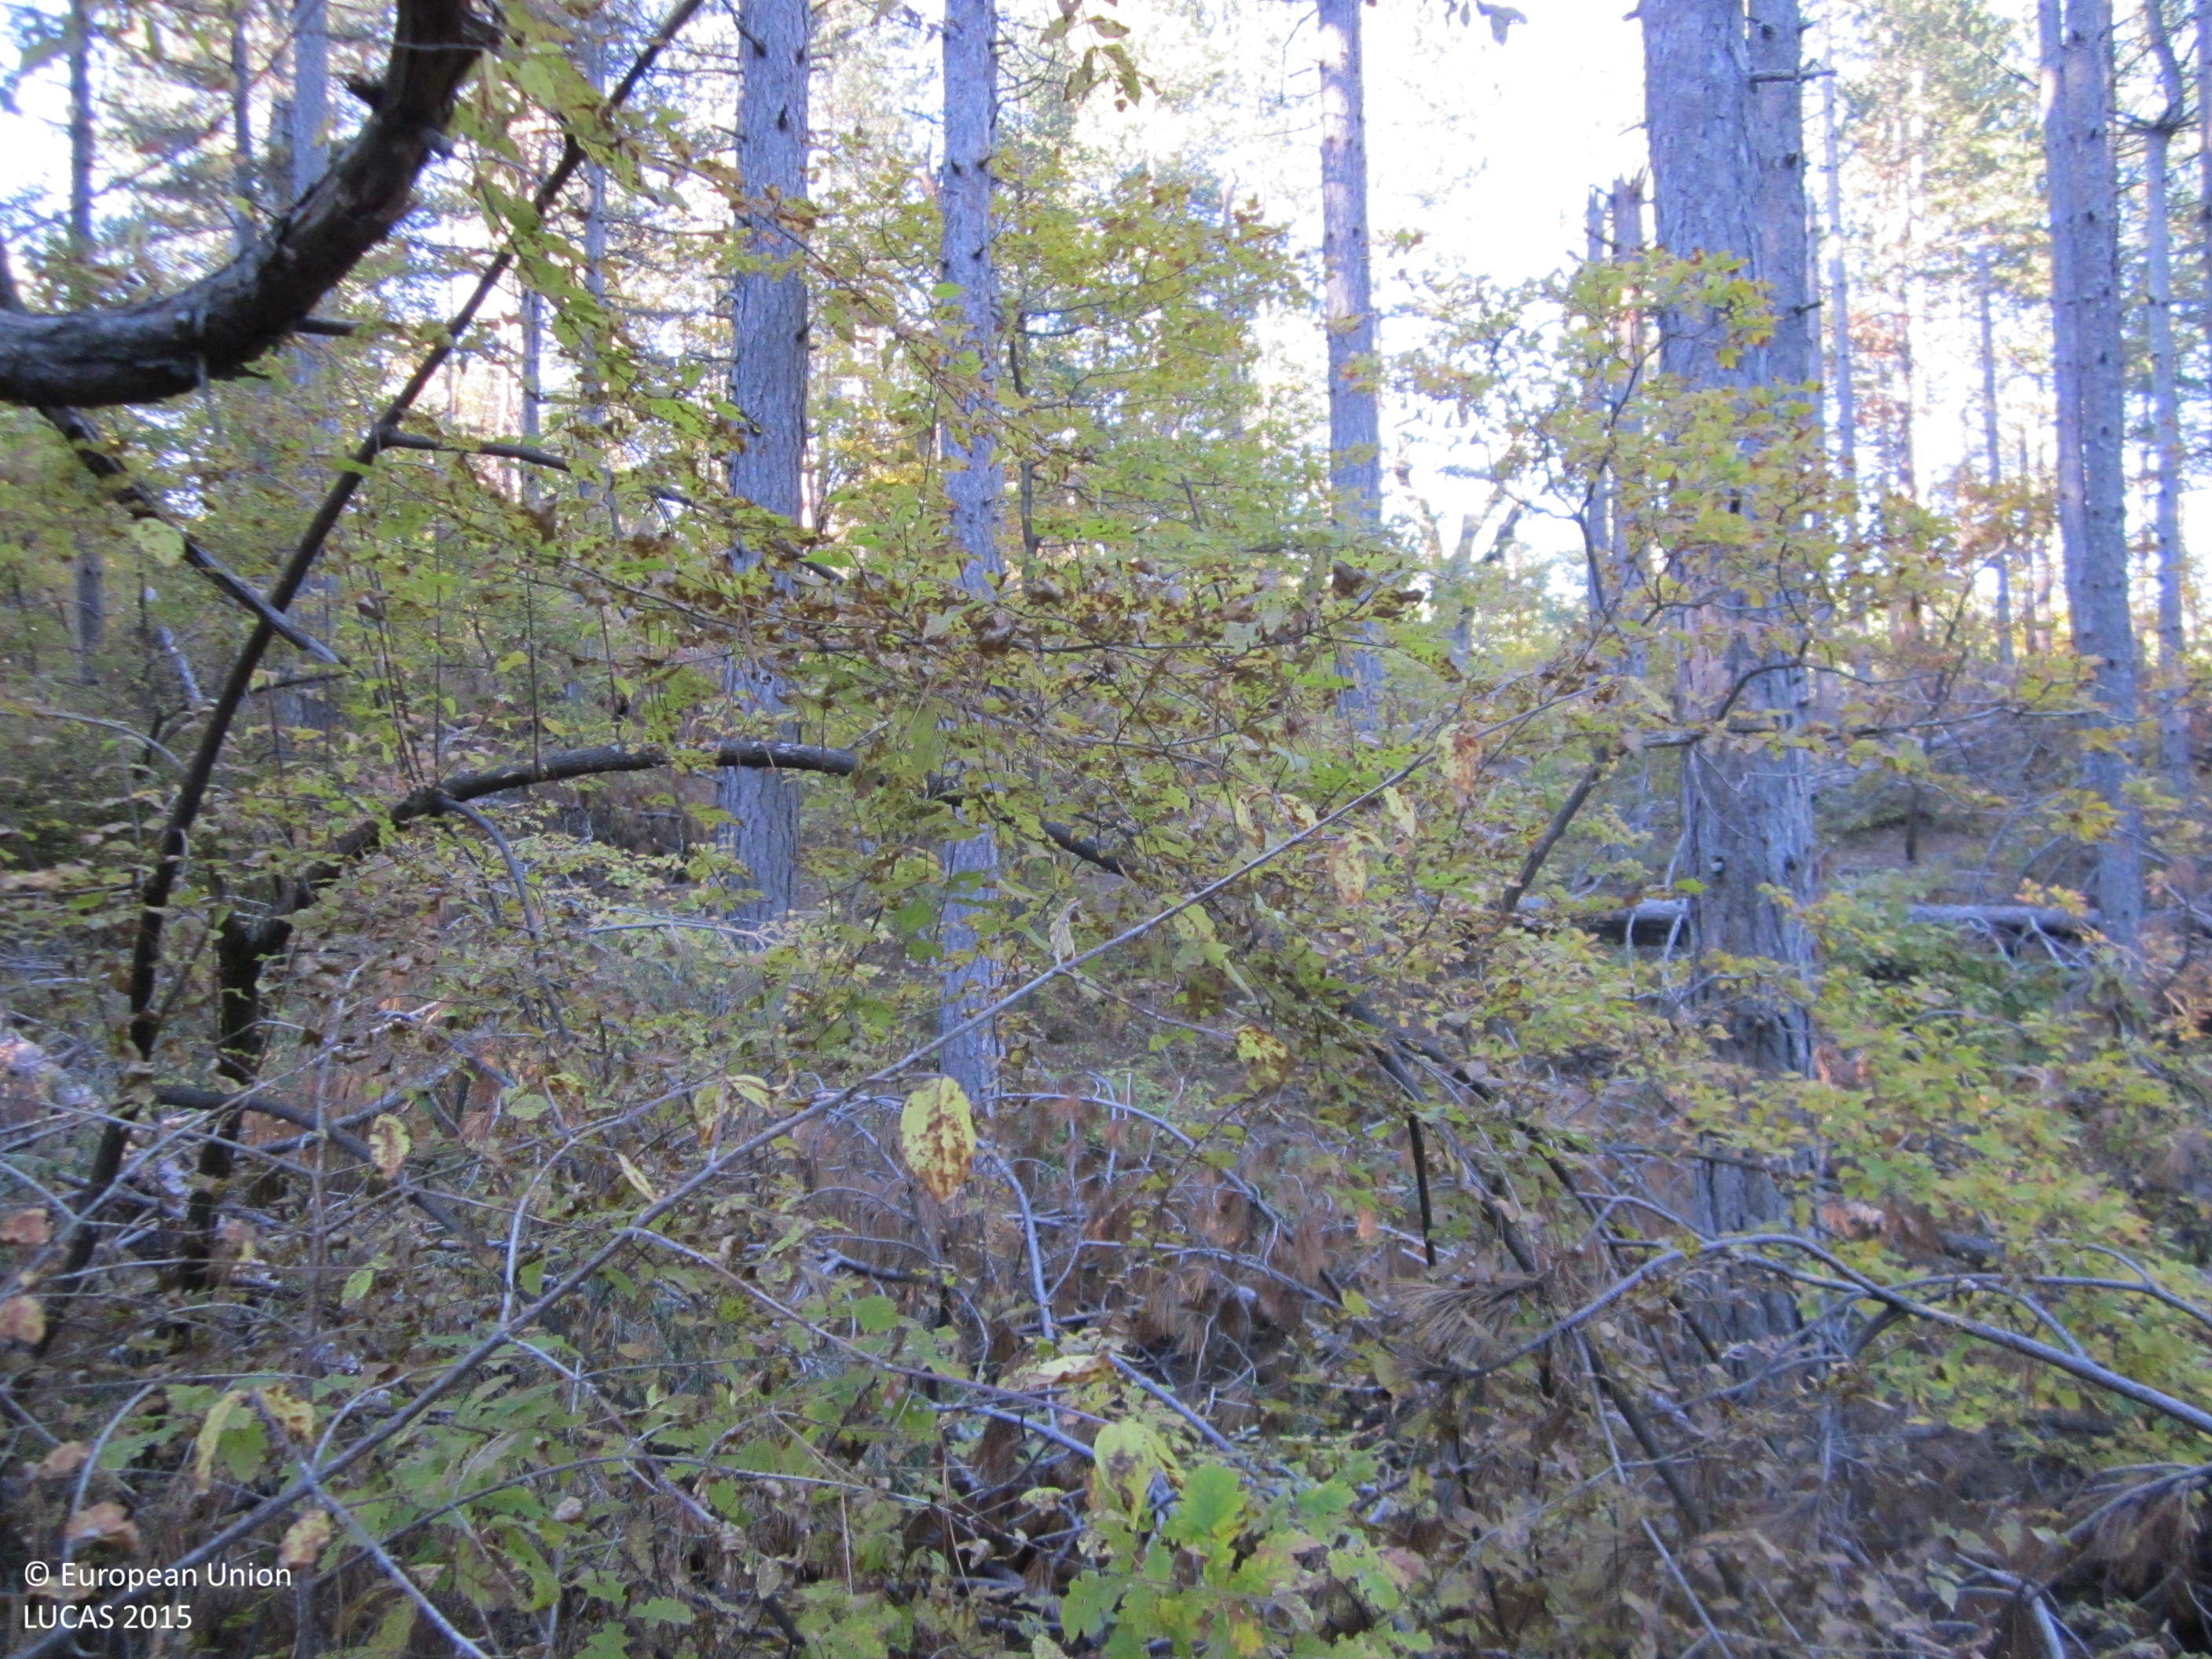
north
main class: Woodland
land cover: Pine dominated coniferous woodland
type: hemiboreal forest and nemoral coniferous forest and mixed broadleaved-coniferous forest
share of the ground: > 75 %
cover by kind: coniferous forest trees 60 %, broadleaved forest trees 20 %, unconsolidated bare surface 15 %, shrubs 5 %
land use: Forestry
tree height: > 5 m
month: November
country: BG
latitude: 41.3707
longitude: 25.7832
